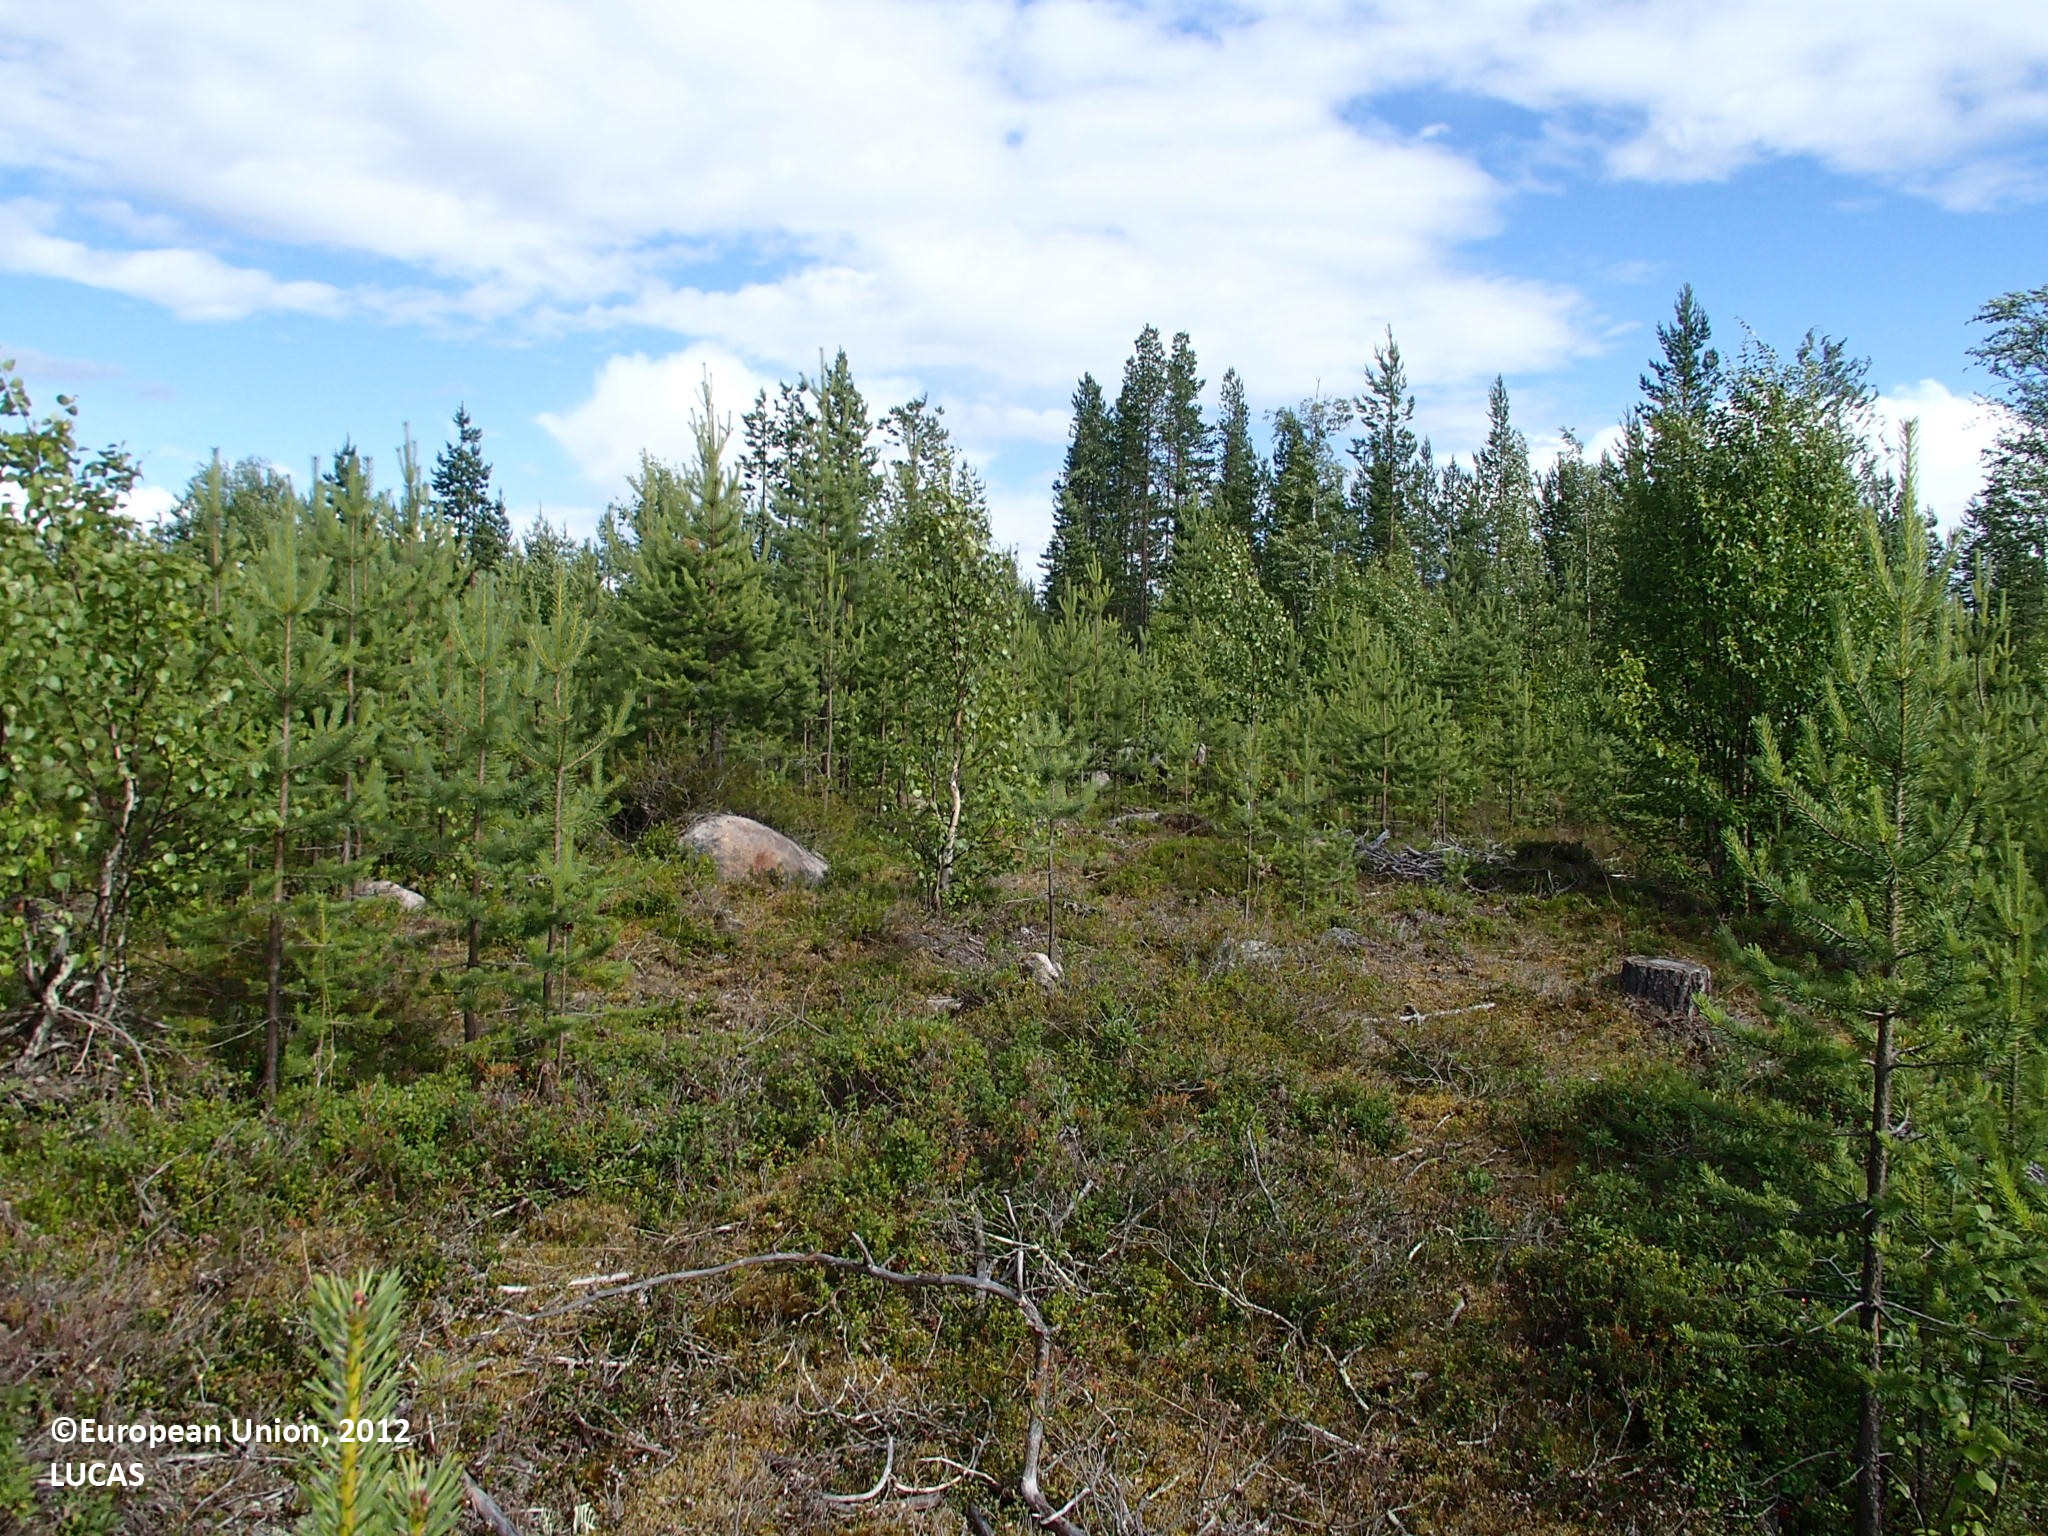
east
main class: Woodland
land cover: Other mixed woodland
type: boreal forest
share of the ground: 25 - 50 %
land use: Forestry
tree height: < 5 m
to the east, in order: Other mixed woodland; Pine dominated coniferous woodland; Other mixed woodland
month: July
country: FI
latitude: 66.6417
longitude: 25.3608
